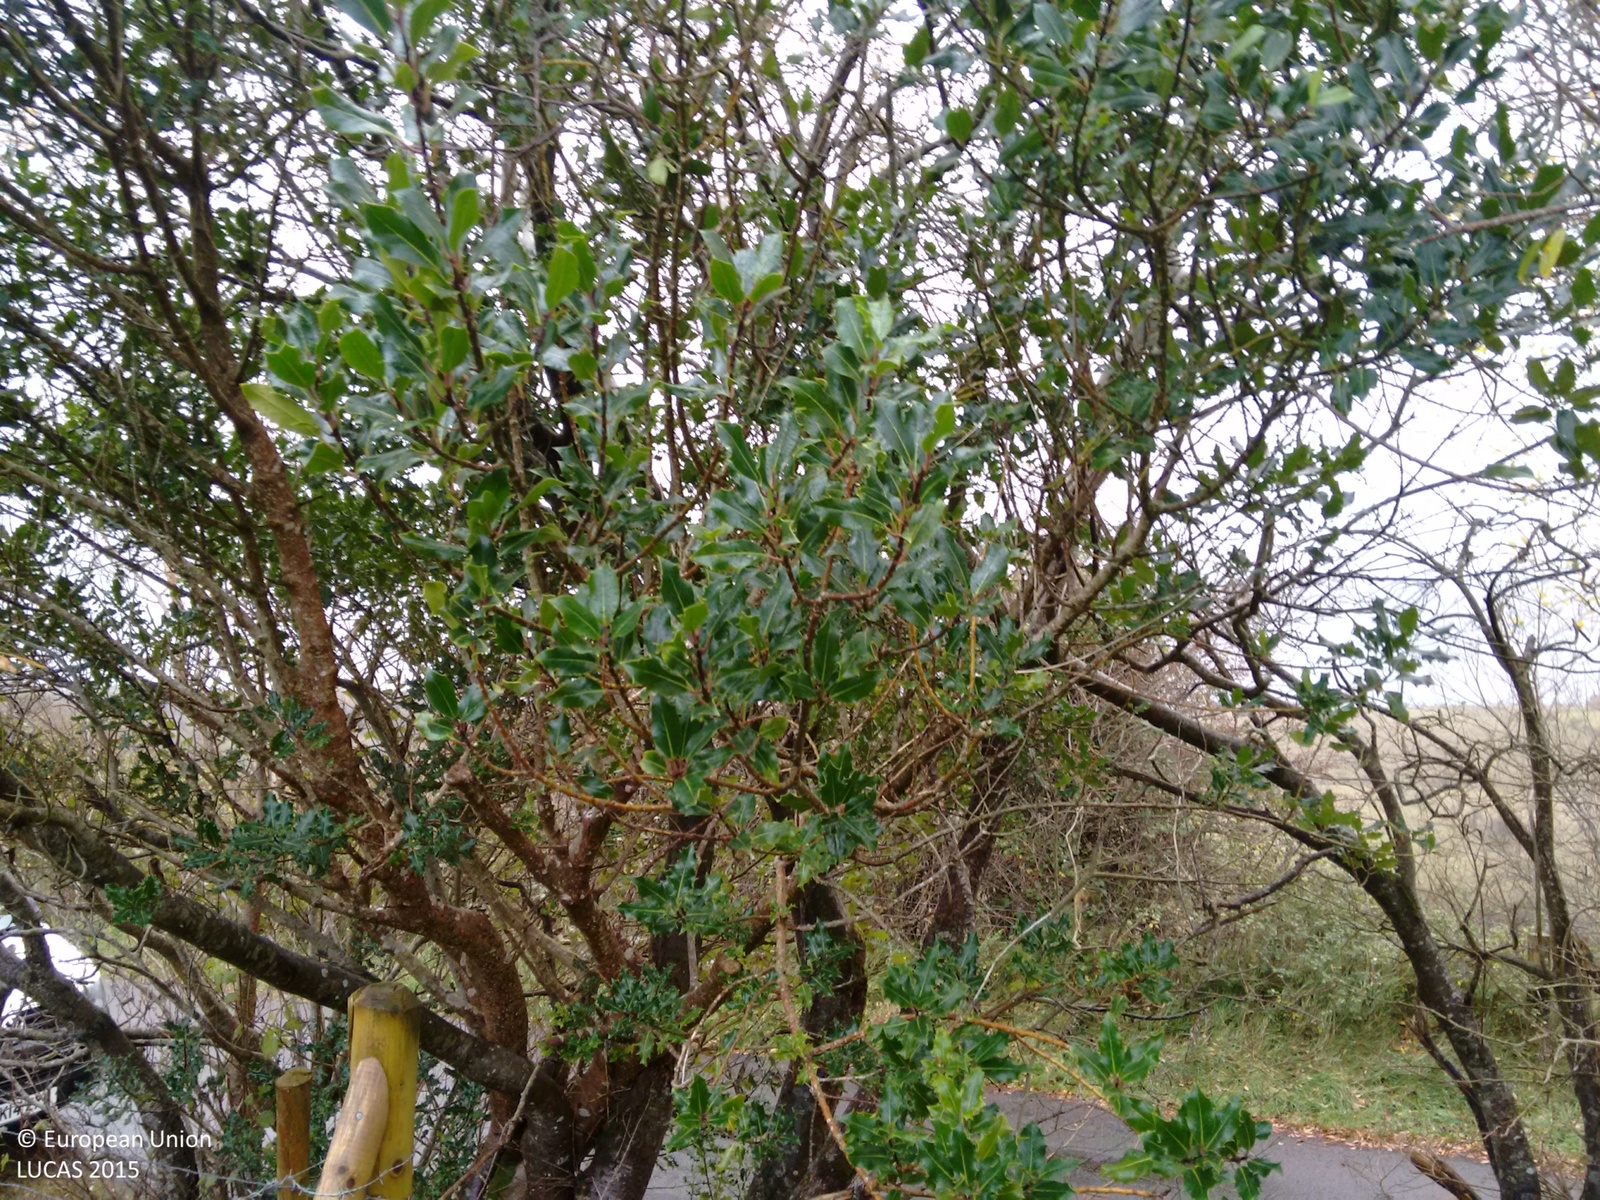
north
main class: Grassland
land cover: Grassland without tree/shrub cover
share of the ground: > 75 %
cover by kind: herbaceous plants 100 %
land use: Agriculture (excluding fallow land and kitchen gardens)
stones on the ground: < 10 %
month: November
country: IE
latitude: 54.4123
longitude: -8.1605
